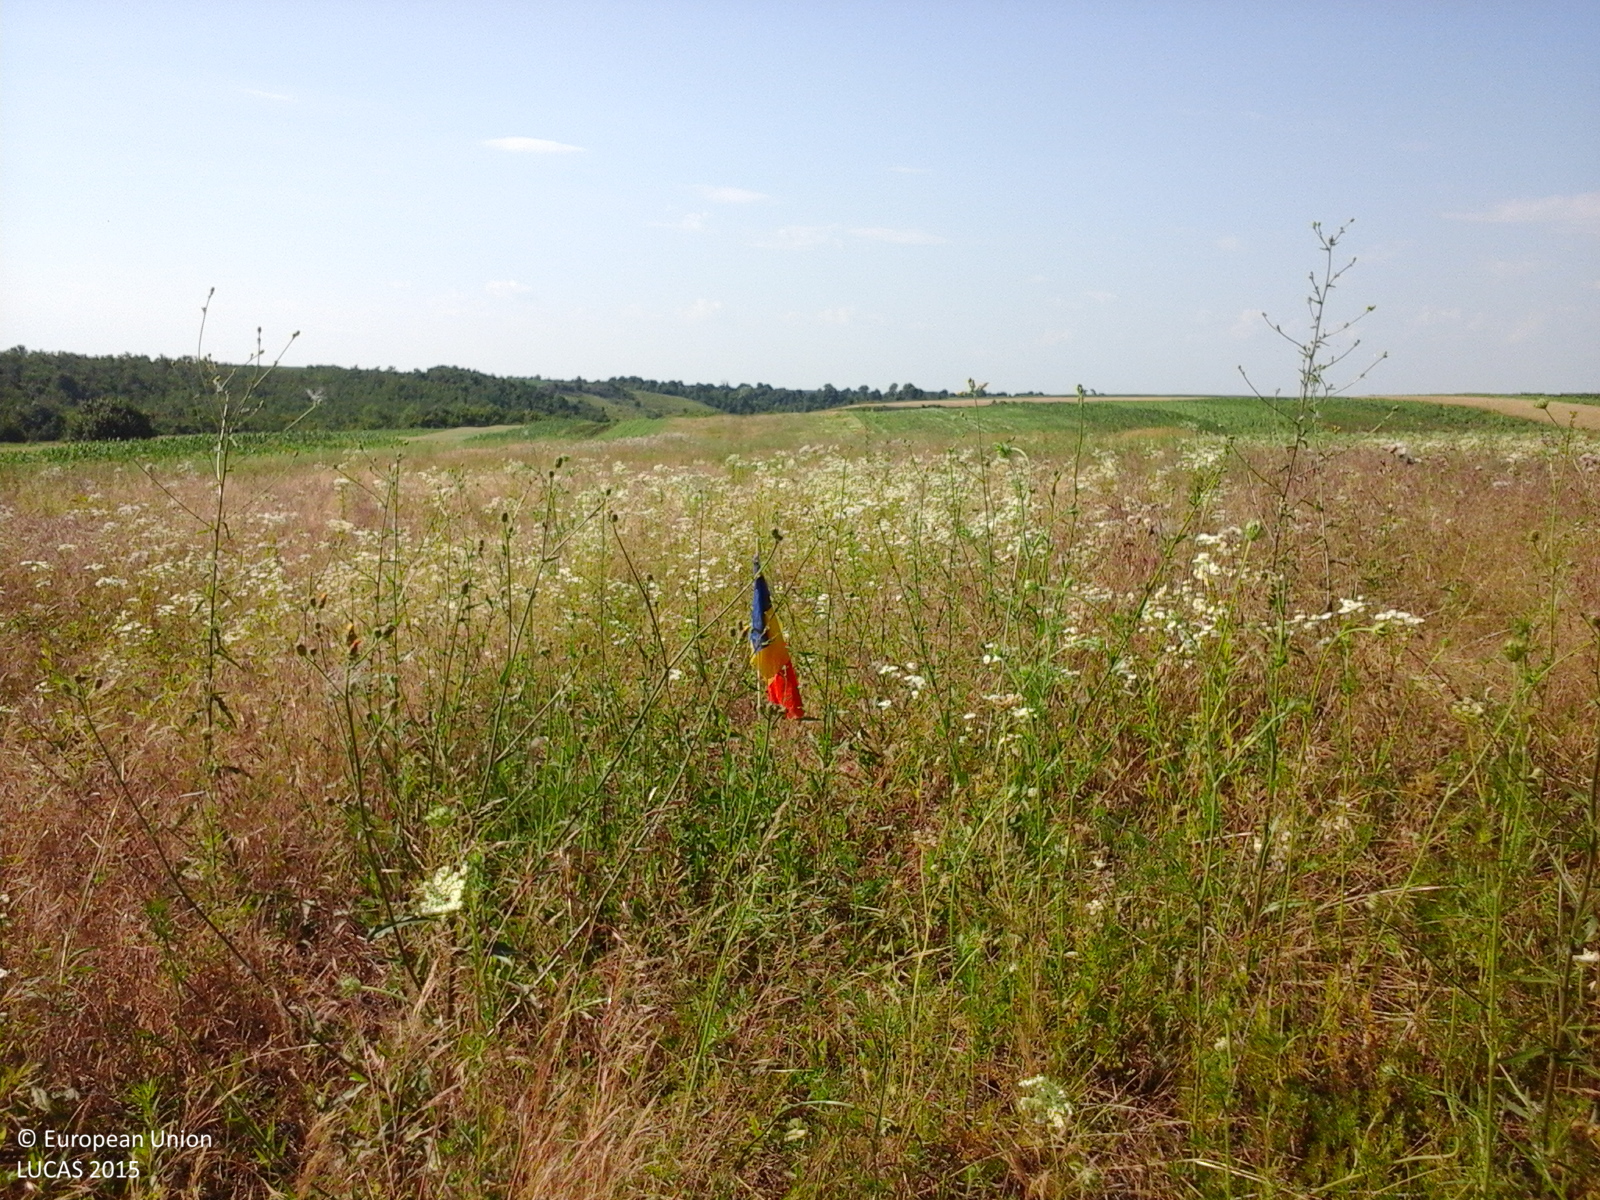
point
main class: Grassland
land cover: Spontaneously vegetated surfaces
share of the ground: > 75 %
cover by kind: herbaceous plants 100 %
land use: Fallow land
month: July
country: RO
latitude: 44.5294
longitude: 24.6585
